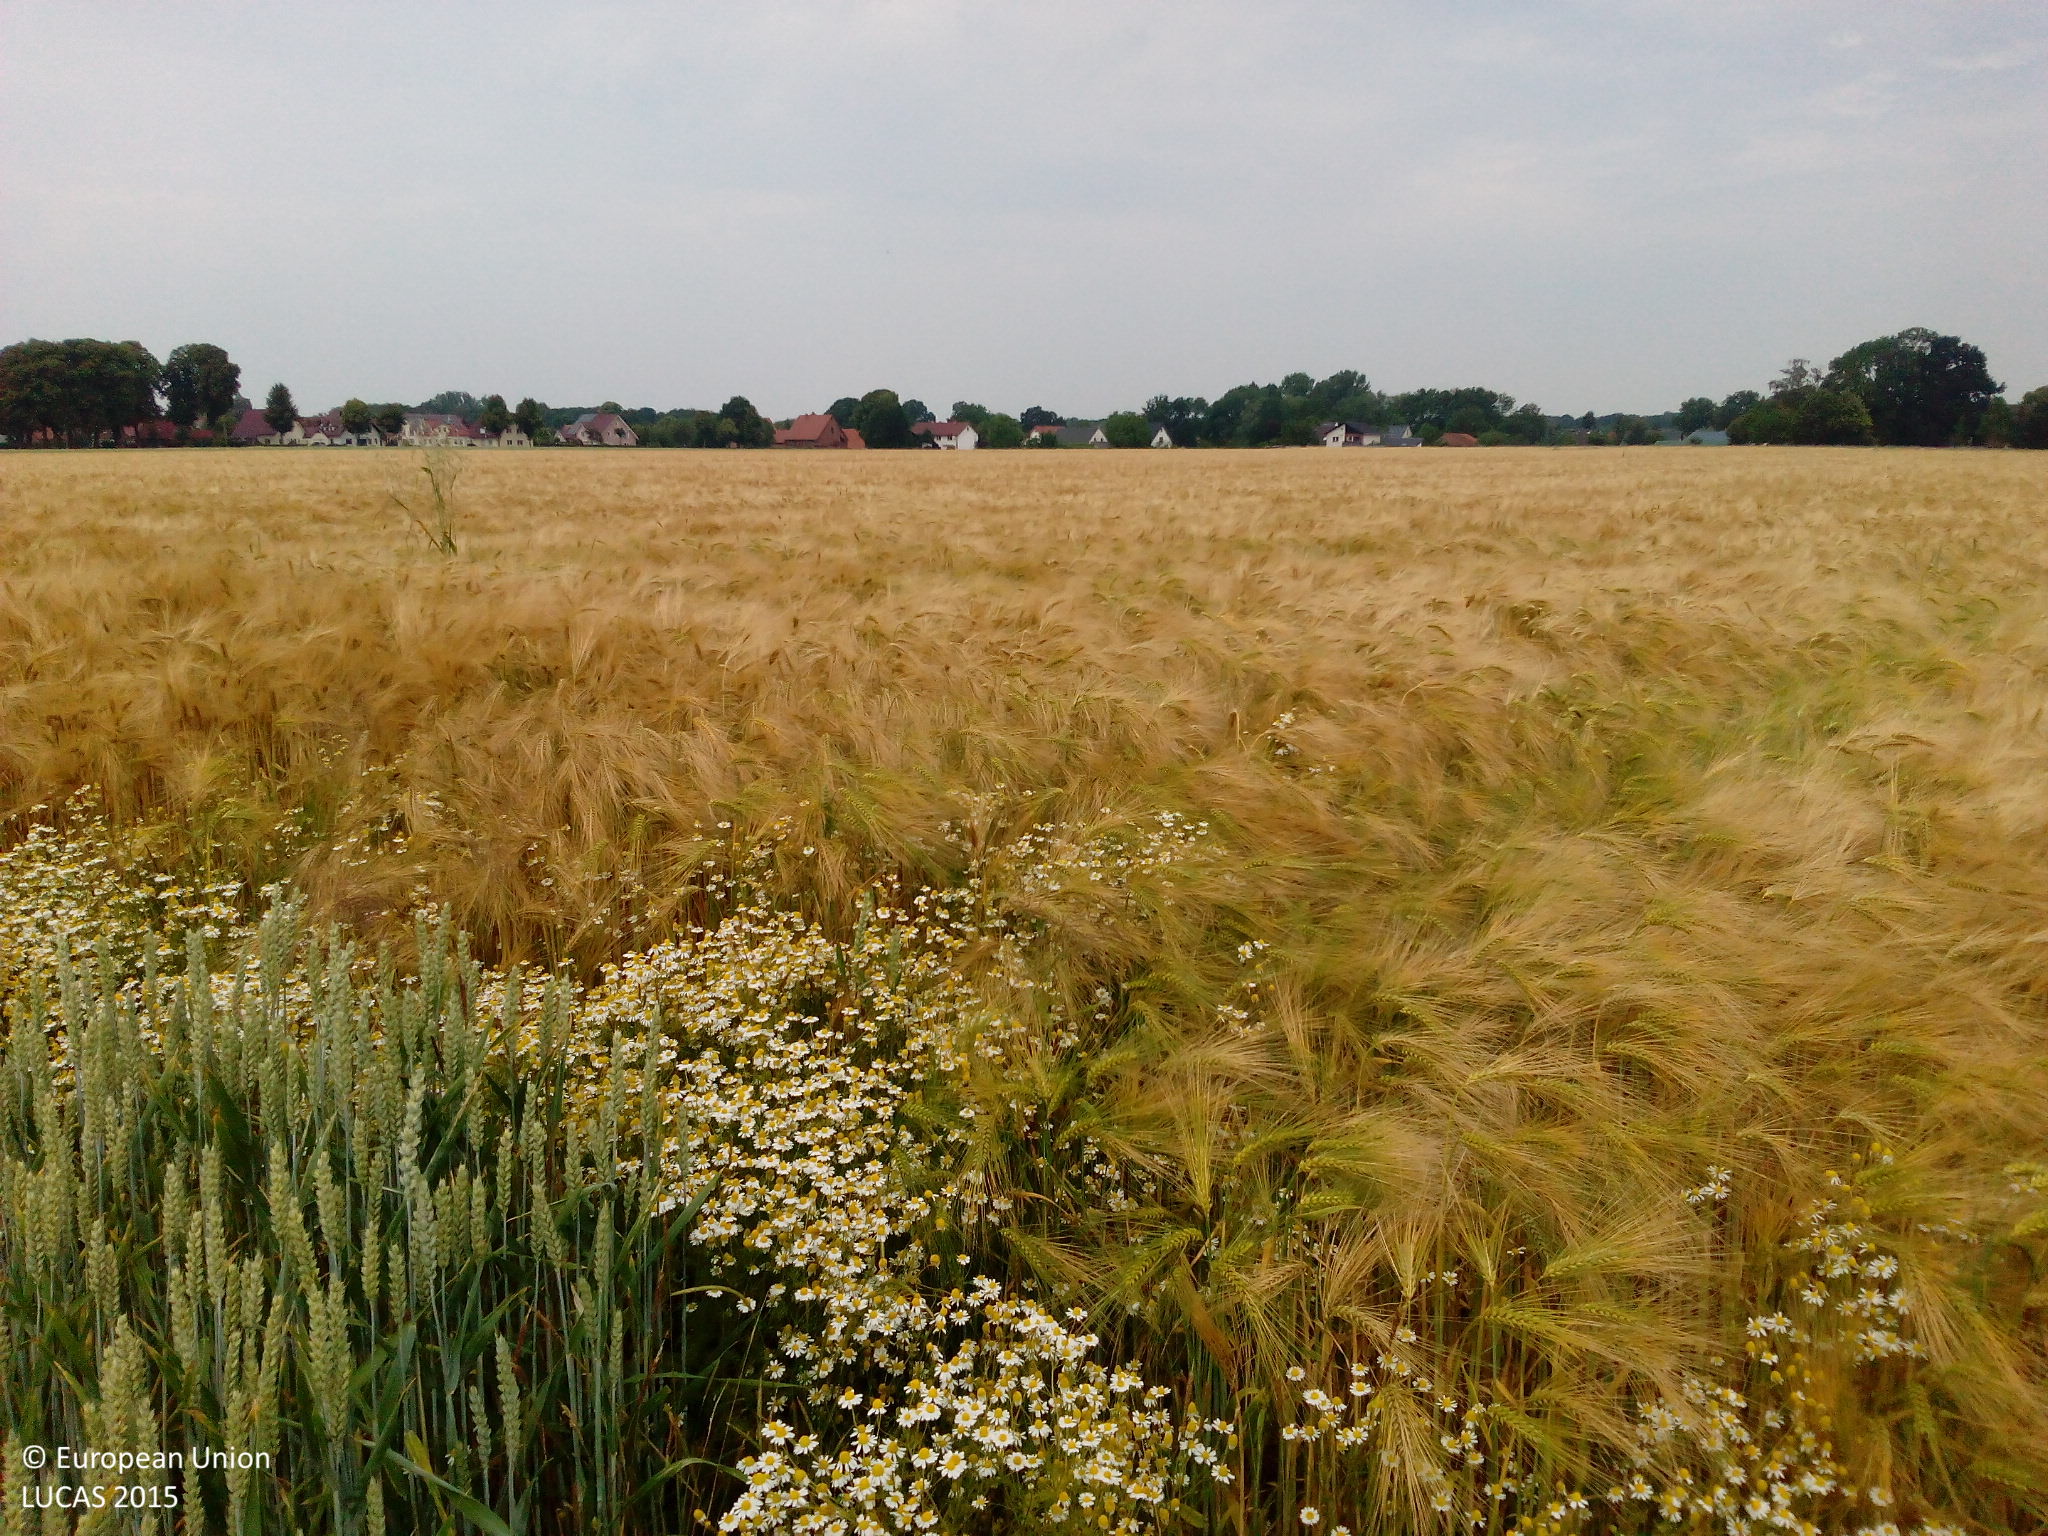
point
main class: Cropland
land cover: Barley
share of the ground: > 75 %
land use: Agriculture (excluding fallow land and kitchen gardens)
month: June
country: DE
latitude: 51.7040
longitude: 8.5967
